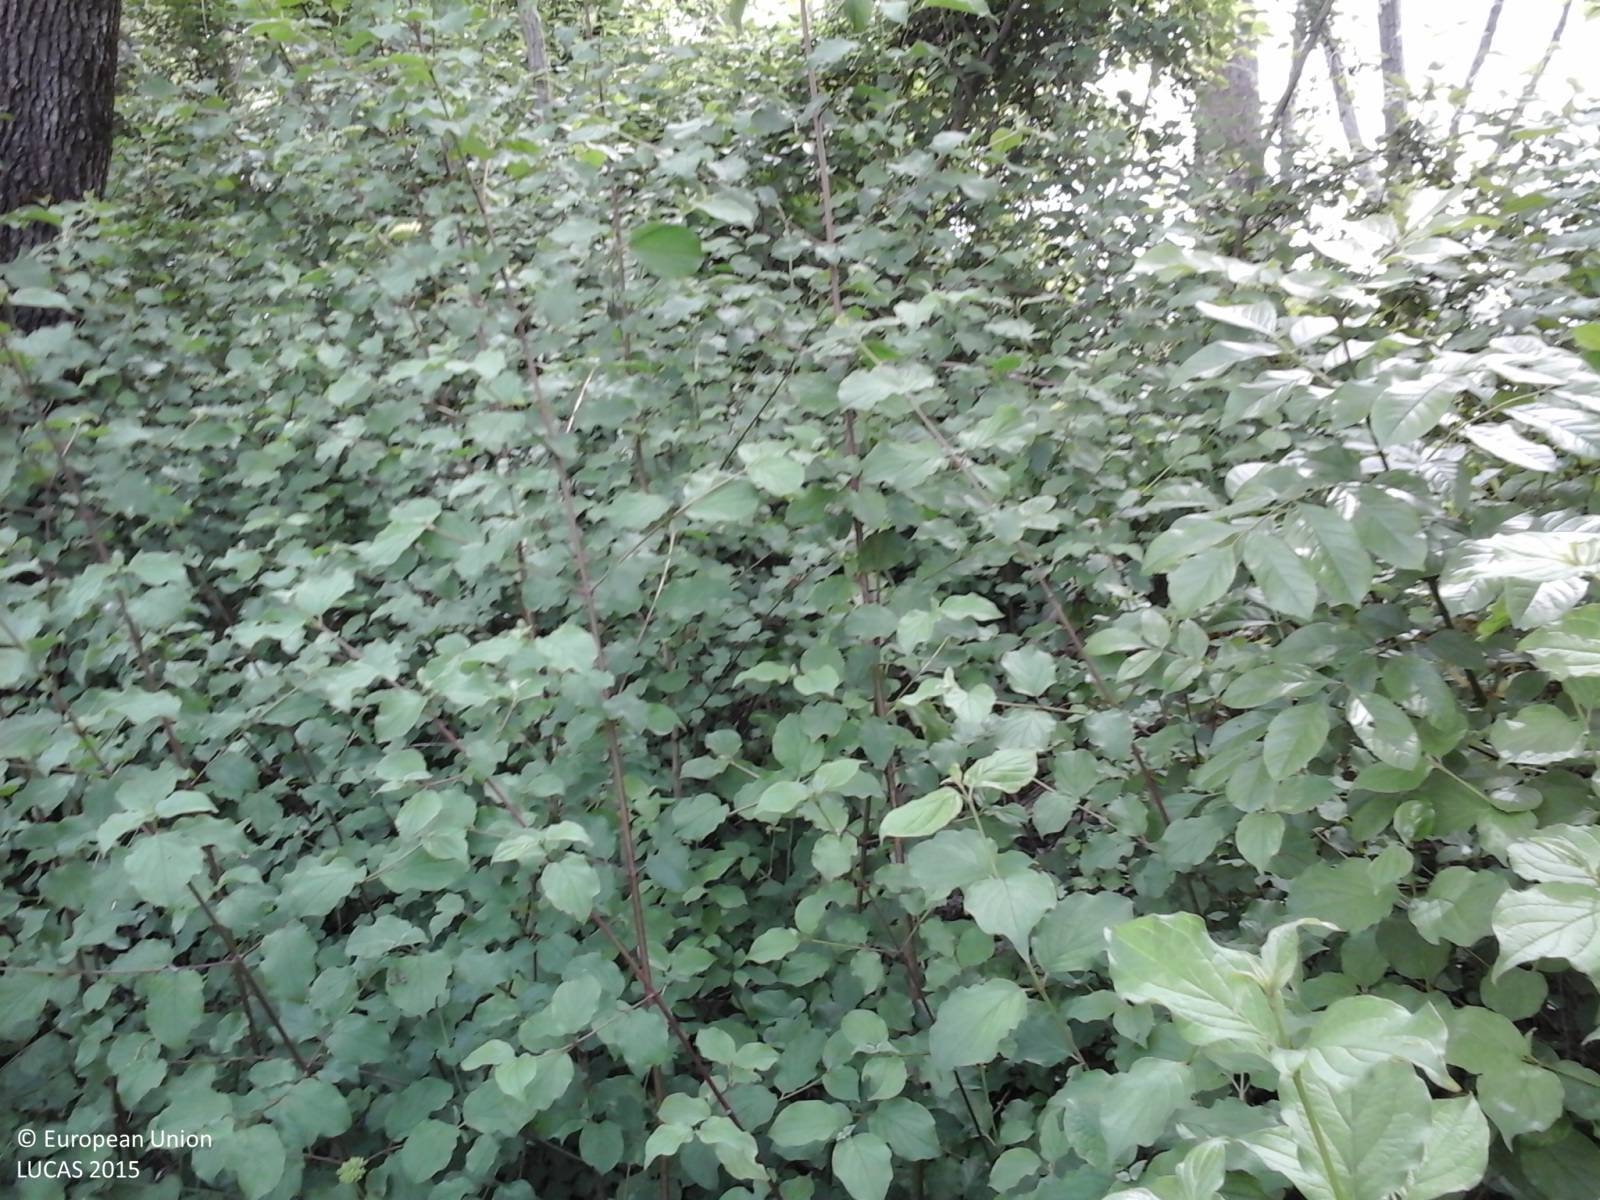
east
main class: Woodland
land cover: Broadleaved woodland
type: floodplain forest
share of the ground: > 75 %
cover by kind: broadleaved forest trees 80 %, shrubs 20 %
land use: Forestry
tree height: > 5 m
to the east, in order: Broadleaved woodland; Ditches and canals; Maize
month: May
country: IT
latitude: 46.1991
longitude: 13.0679
